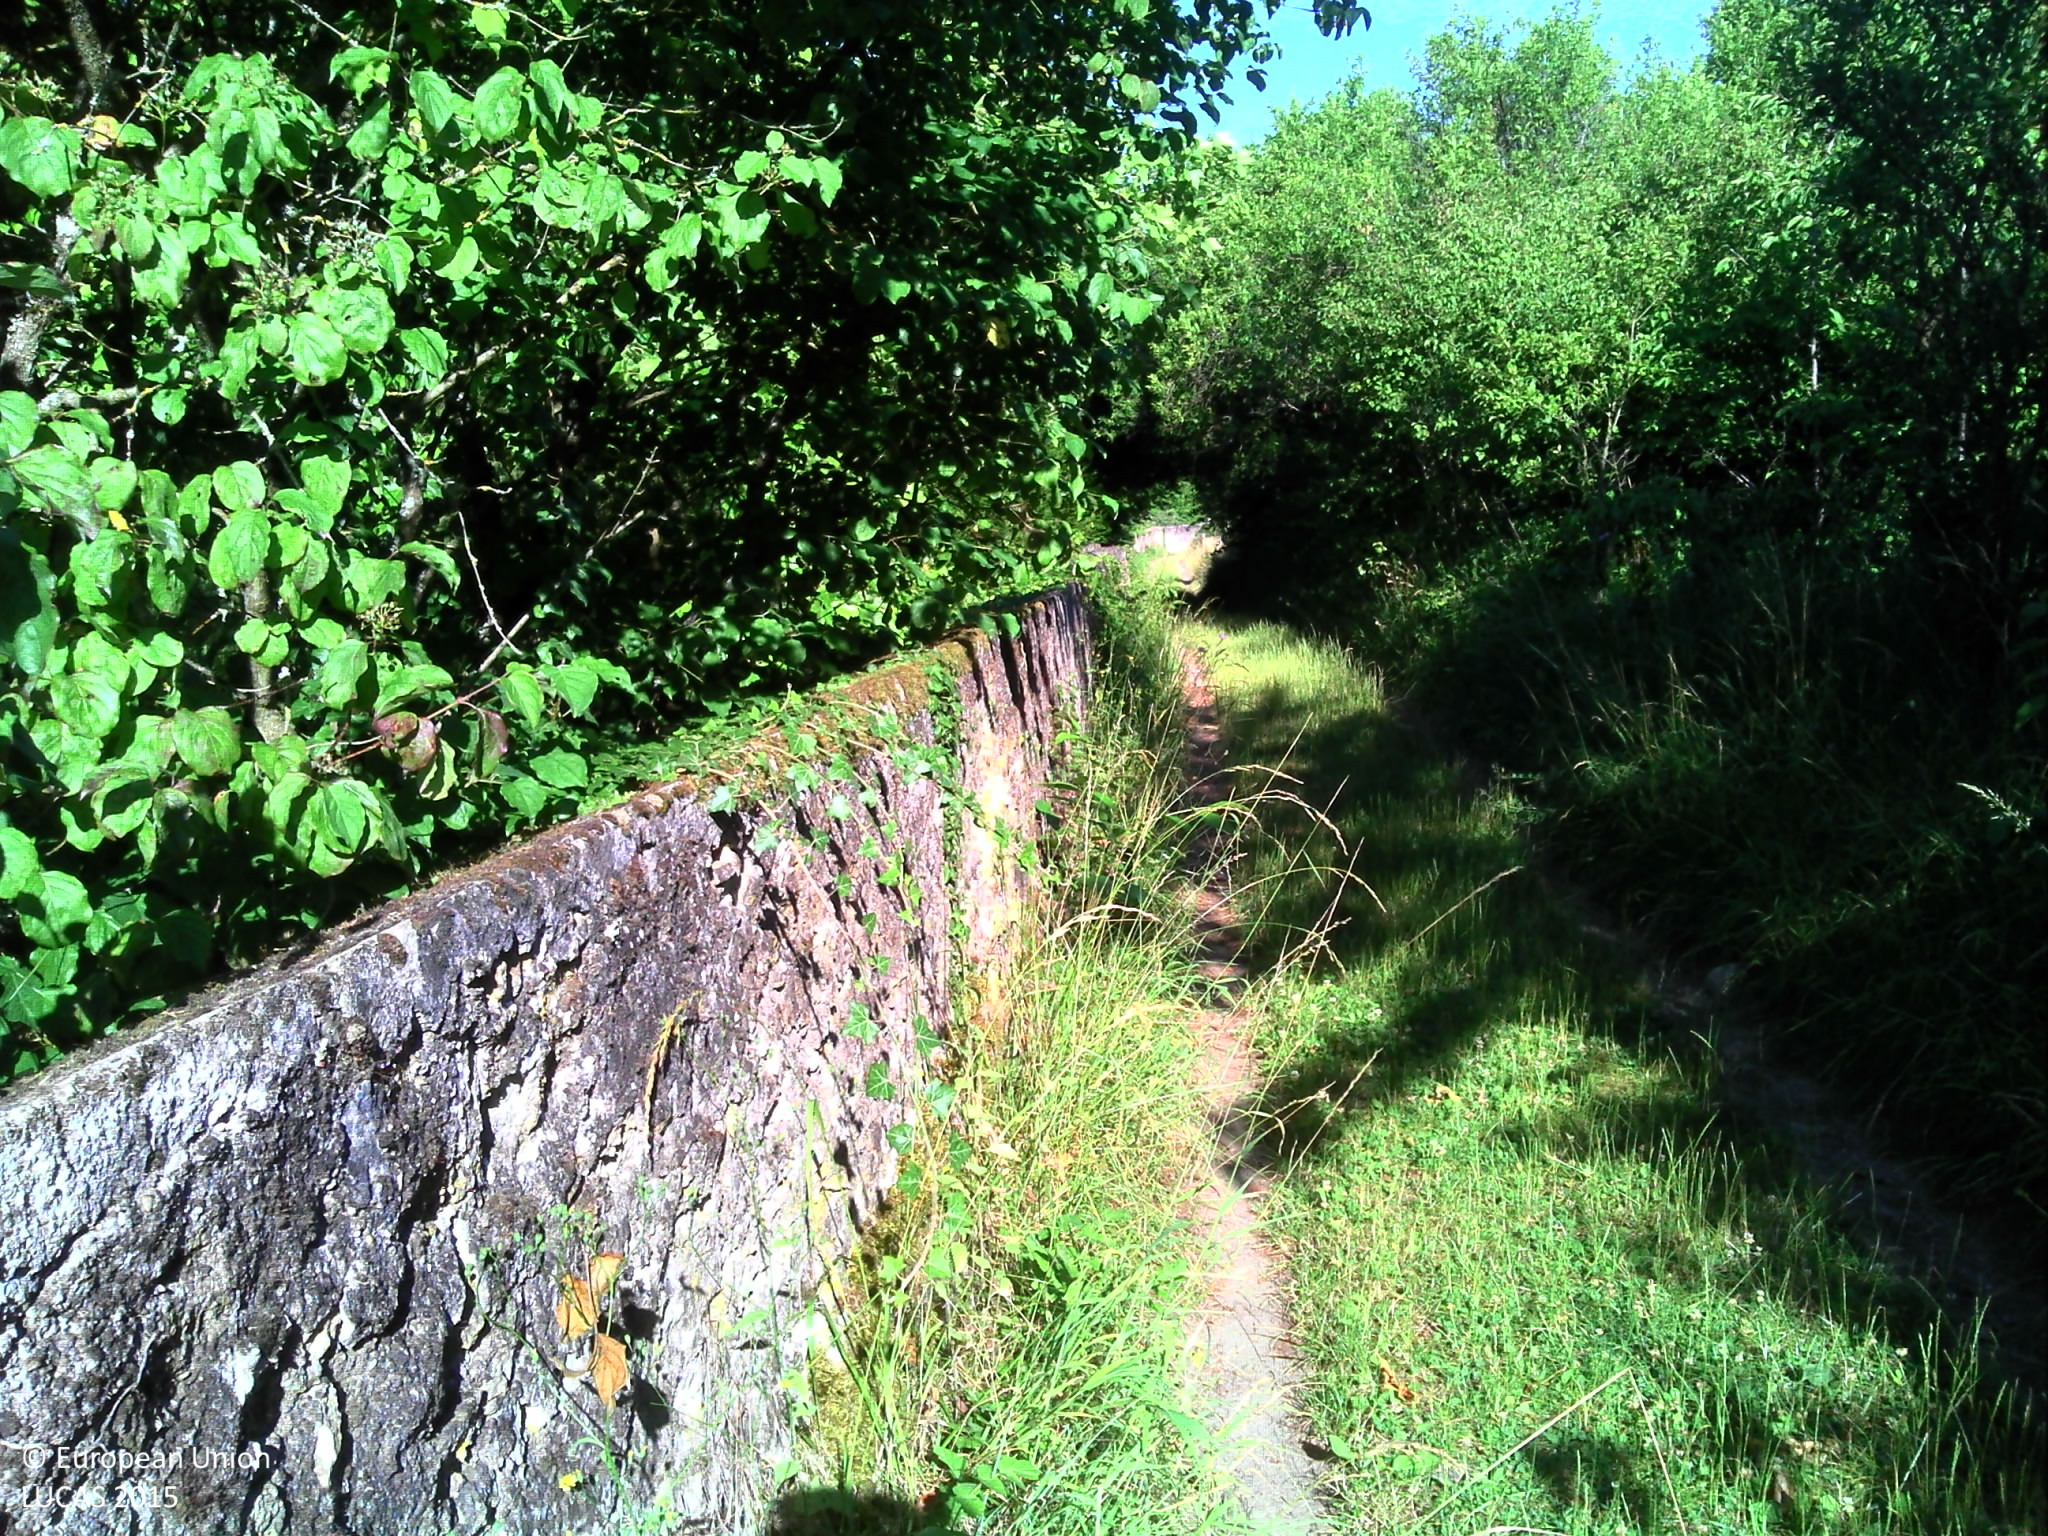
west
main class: Grassland
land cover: Grassland with sparse tree/shrub cover
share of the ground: > 75 %
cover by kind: herbaceous plants 95 %, broadleaved forest trees 5 %
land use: Residential
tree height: > 5 m
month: June
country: FR
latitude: 49.0154
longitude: 5.9933
